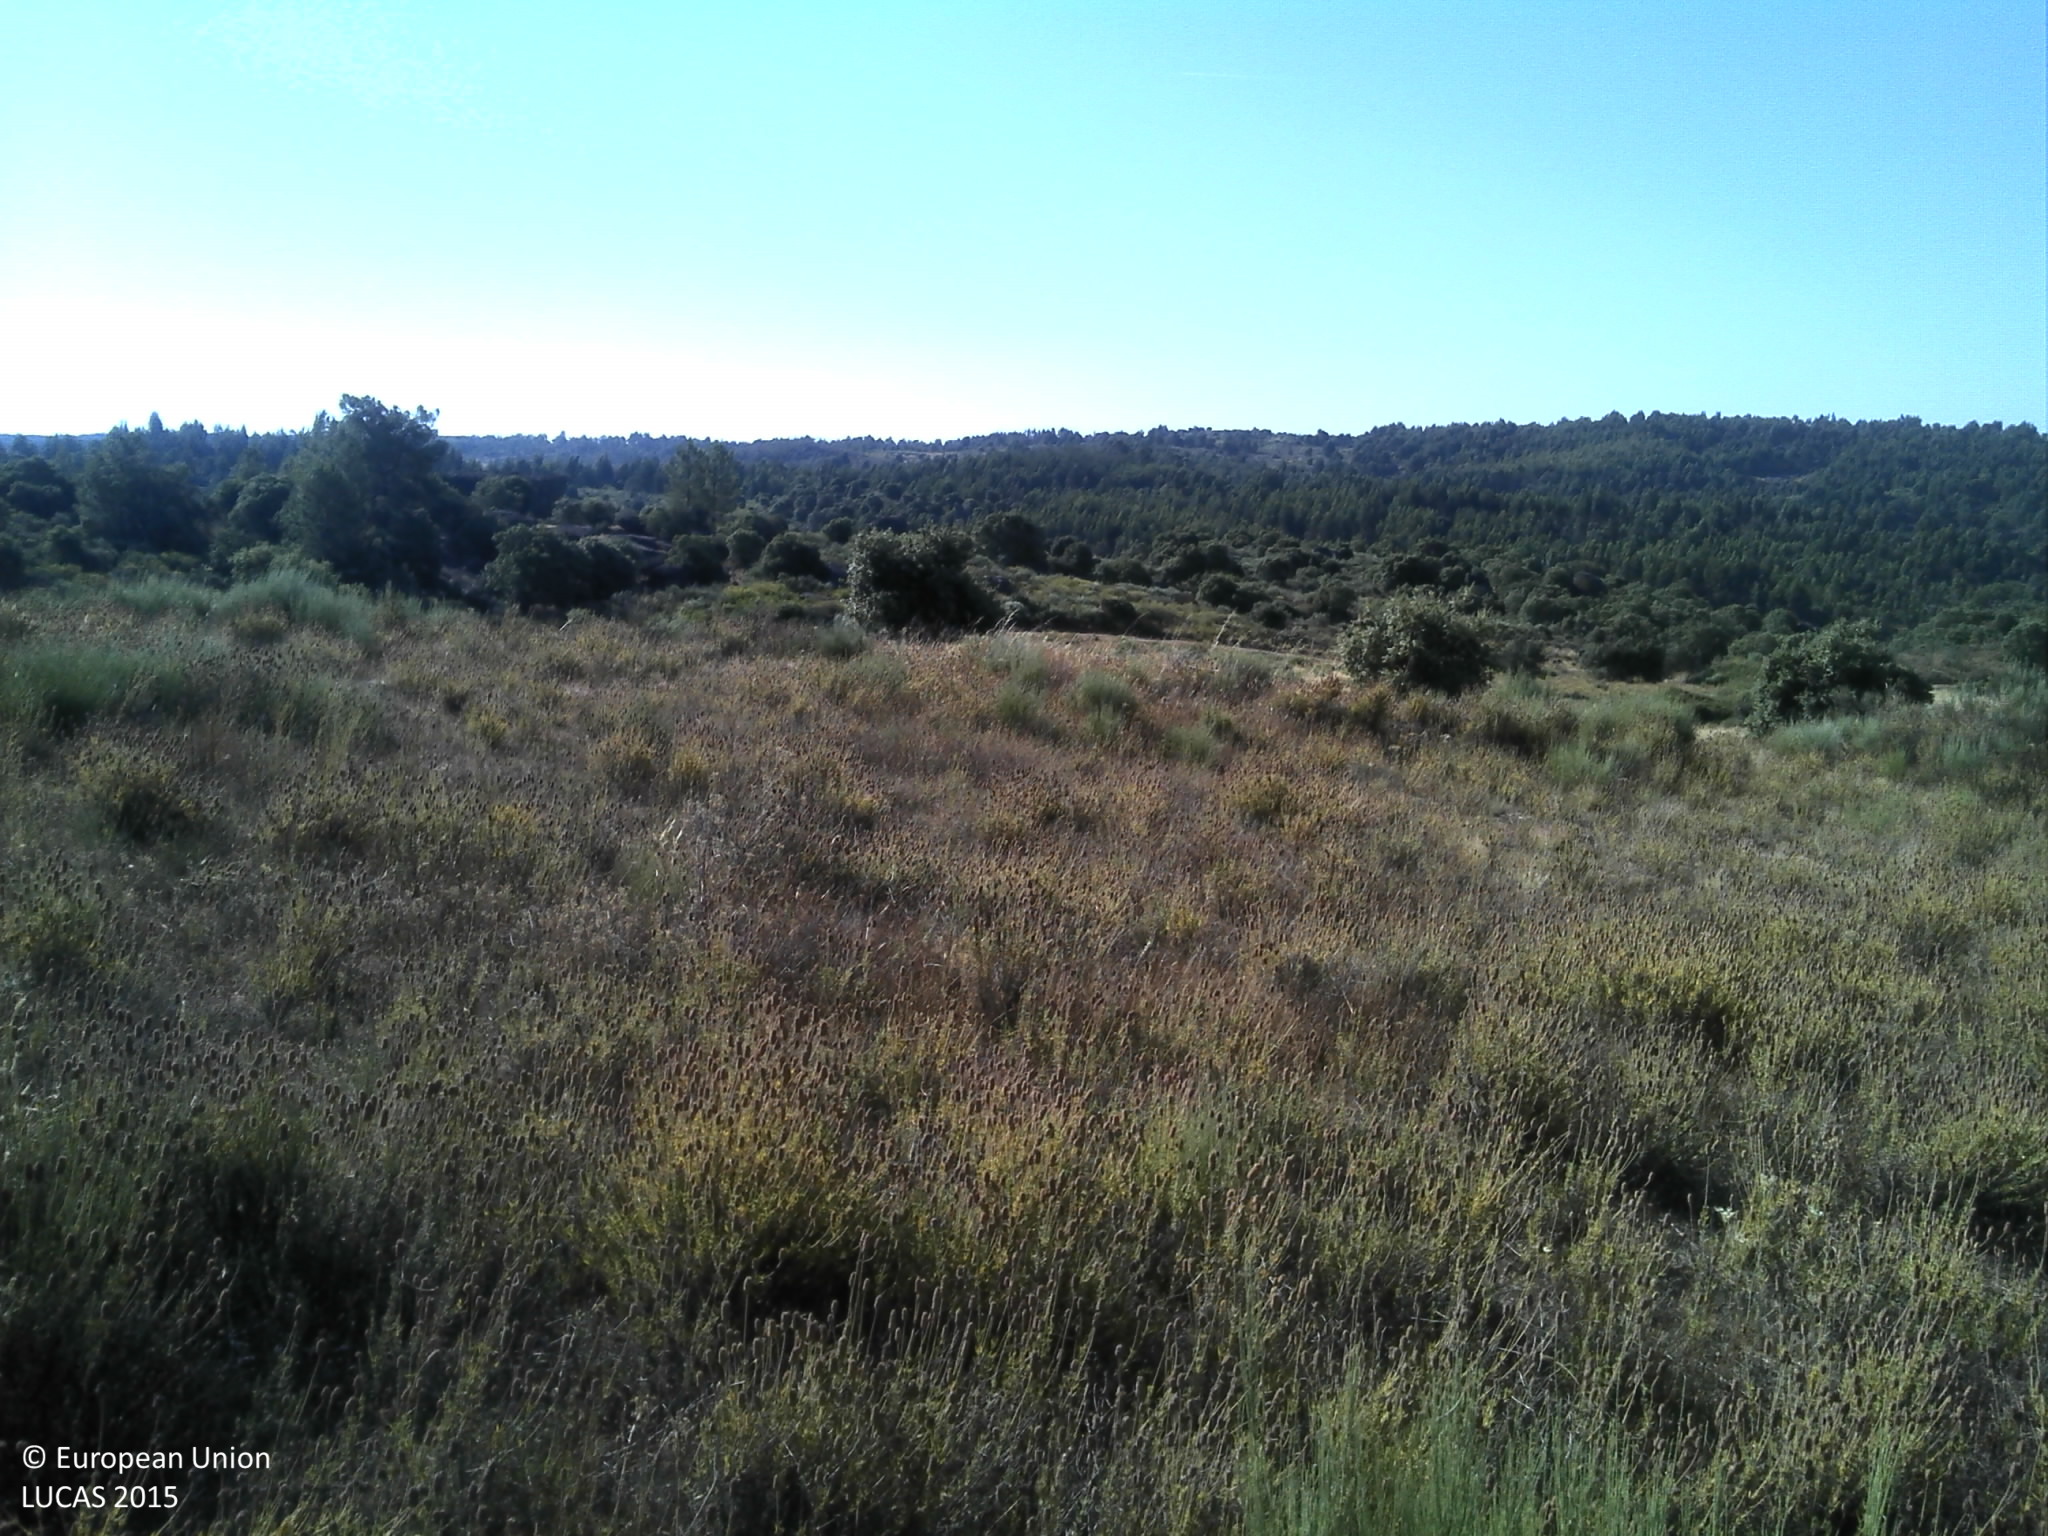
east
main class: Shrubland
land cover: Shrubland with sparse tree cover
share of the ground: 50 - 75 %
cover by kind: shrubs 40 %, herbaceous plants 25 %, unconsolidated bare surface 25 %, broadleaved forest trees 5 %
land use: Agriculture (excluding fallow land and kitchen gardens)
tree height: > 5 m
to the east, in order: Shrubland with sparse tree cover; Grassland with sparse tree/shrub cover; Tracks; Broadleaved woodland; Shrubland without tree cover; Grassland without tree/shrub cover
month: June
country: PT
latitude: 40.0604
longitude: -7.3210
